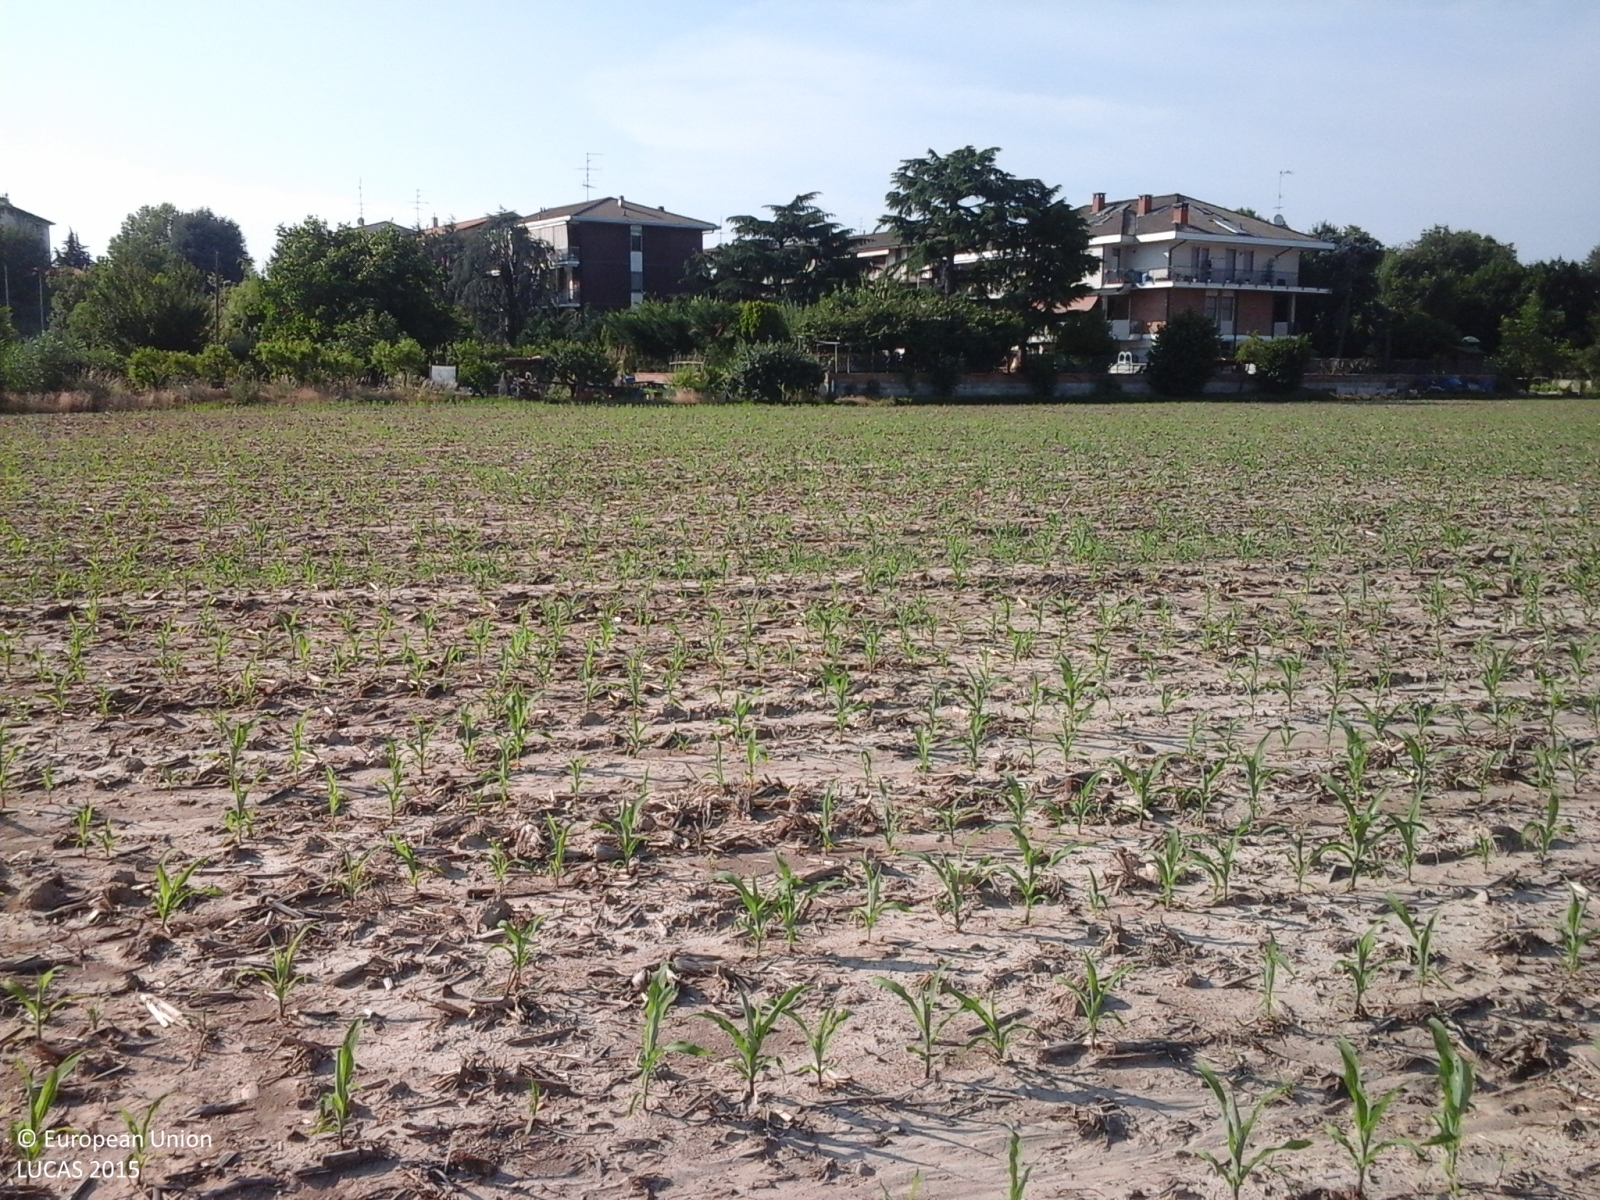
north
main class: Cropland
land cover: Maize
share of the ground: 10 - 25 %
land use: Agriculture (excluding fallow land and kitchen gardens)
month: June
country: IT
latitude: 45.4595
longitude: 8.6339
